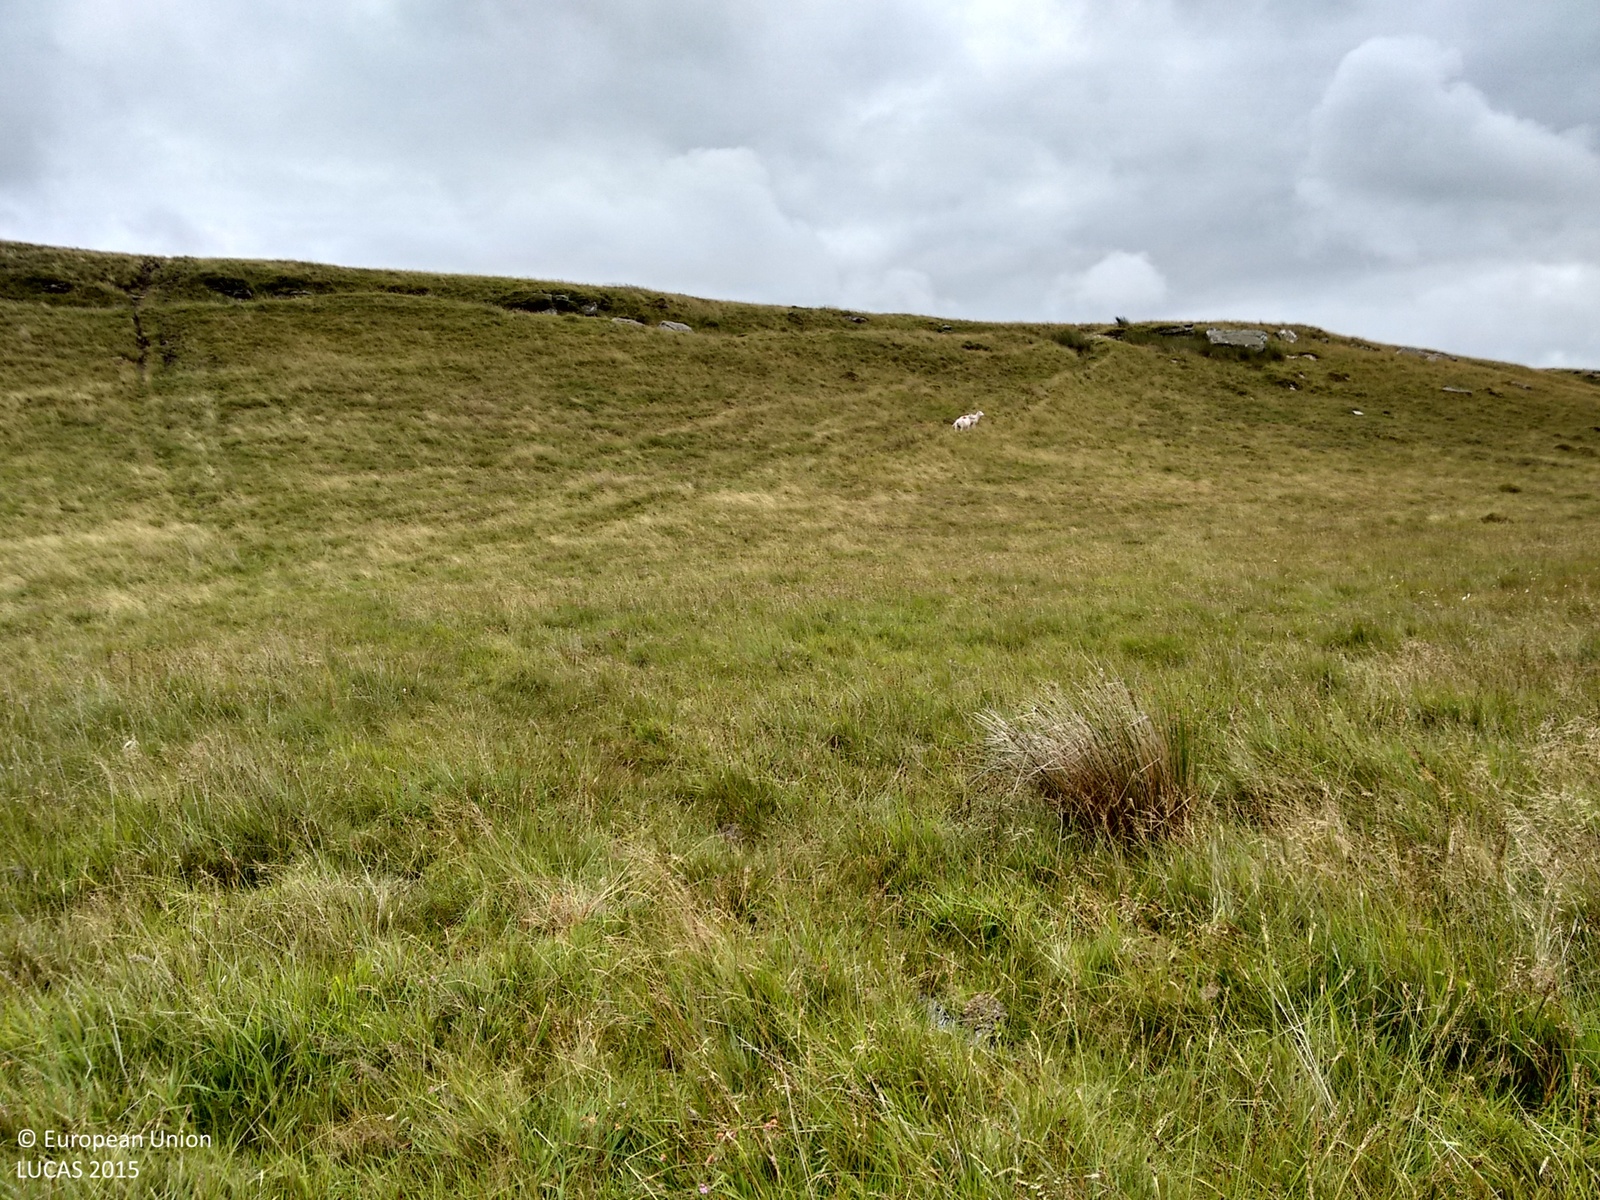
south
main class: Grassland
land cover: Grassland without tree/shrub cover
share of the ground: > 75 %
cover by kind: herbaceous plants 100 %
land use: Agriculture (excluding fallow land and kitchen gardens)
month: July
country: GB
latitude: 51.7621
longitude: -3.8414
